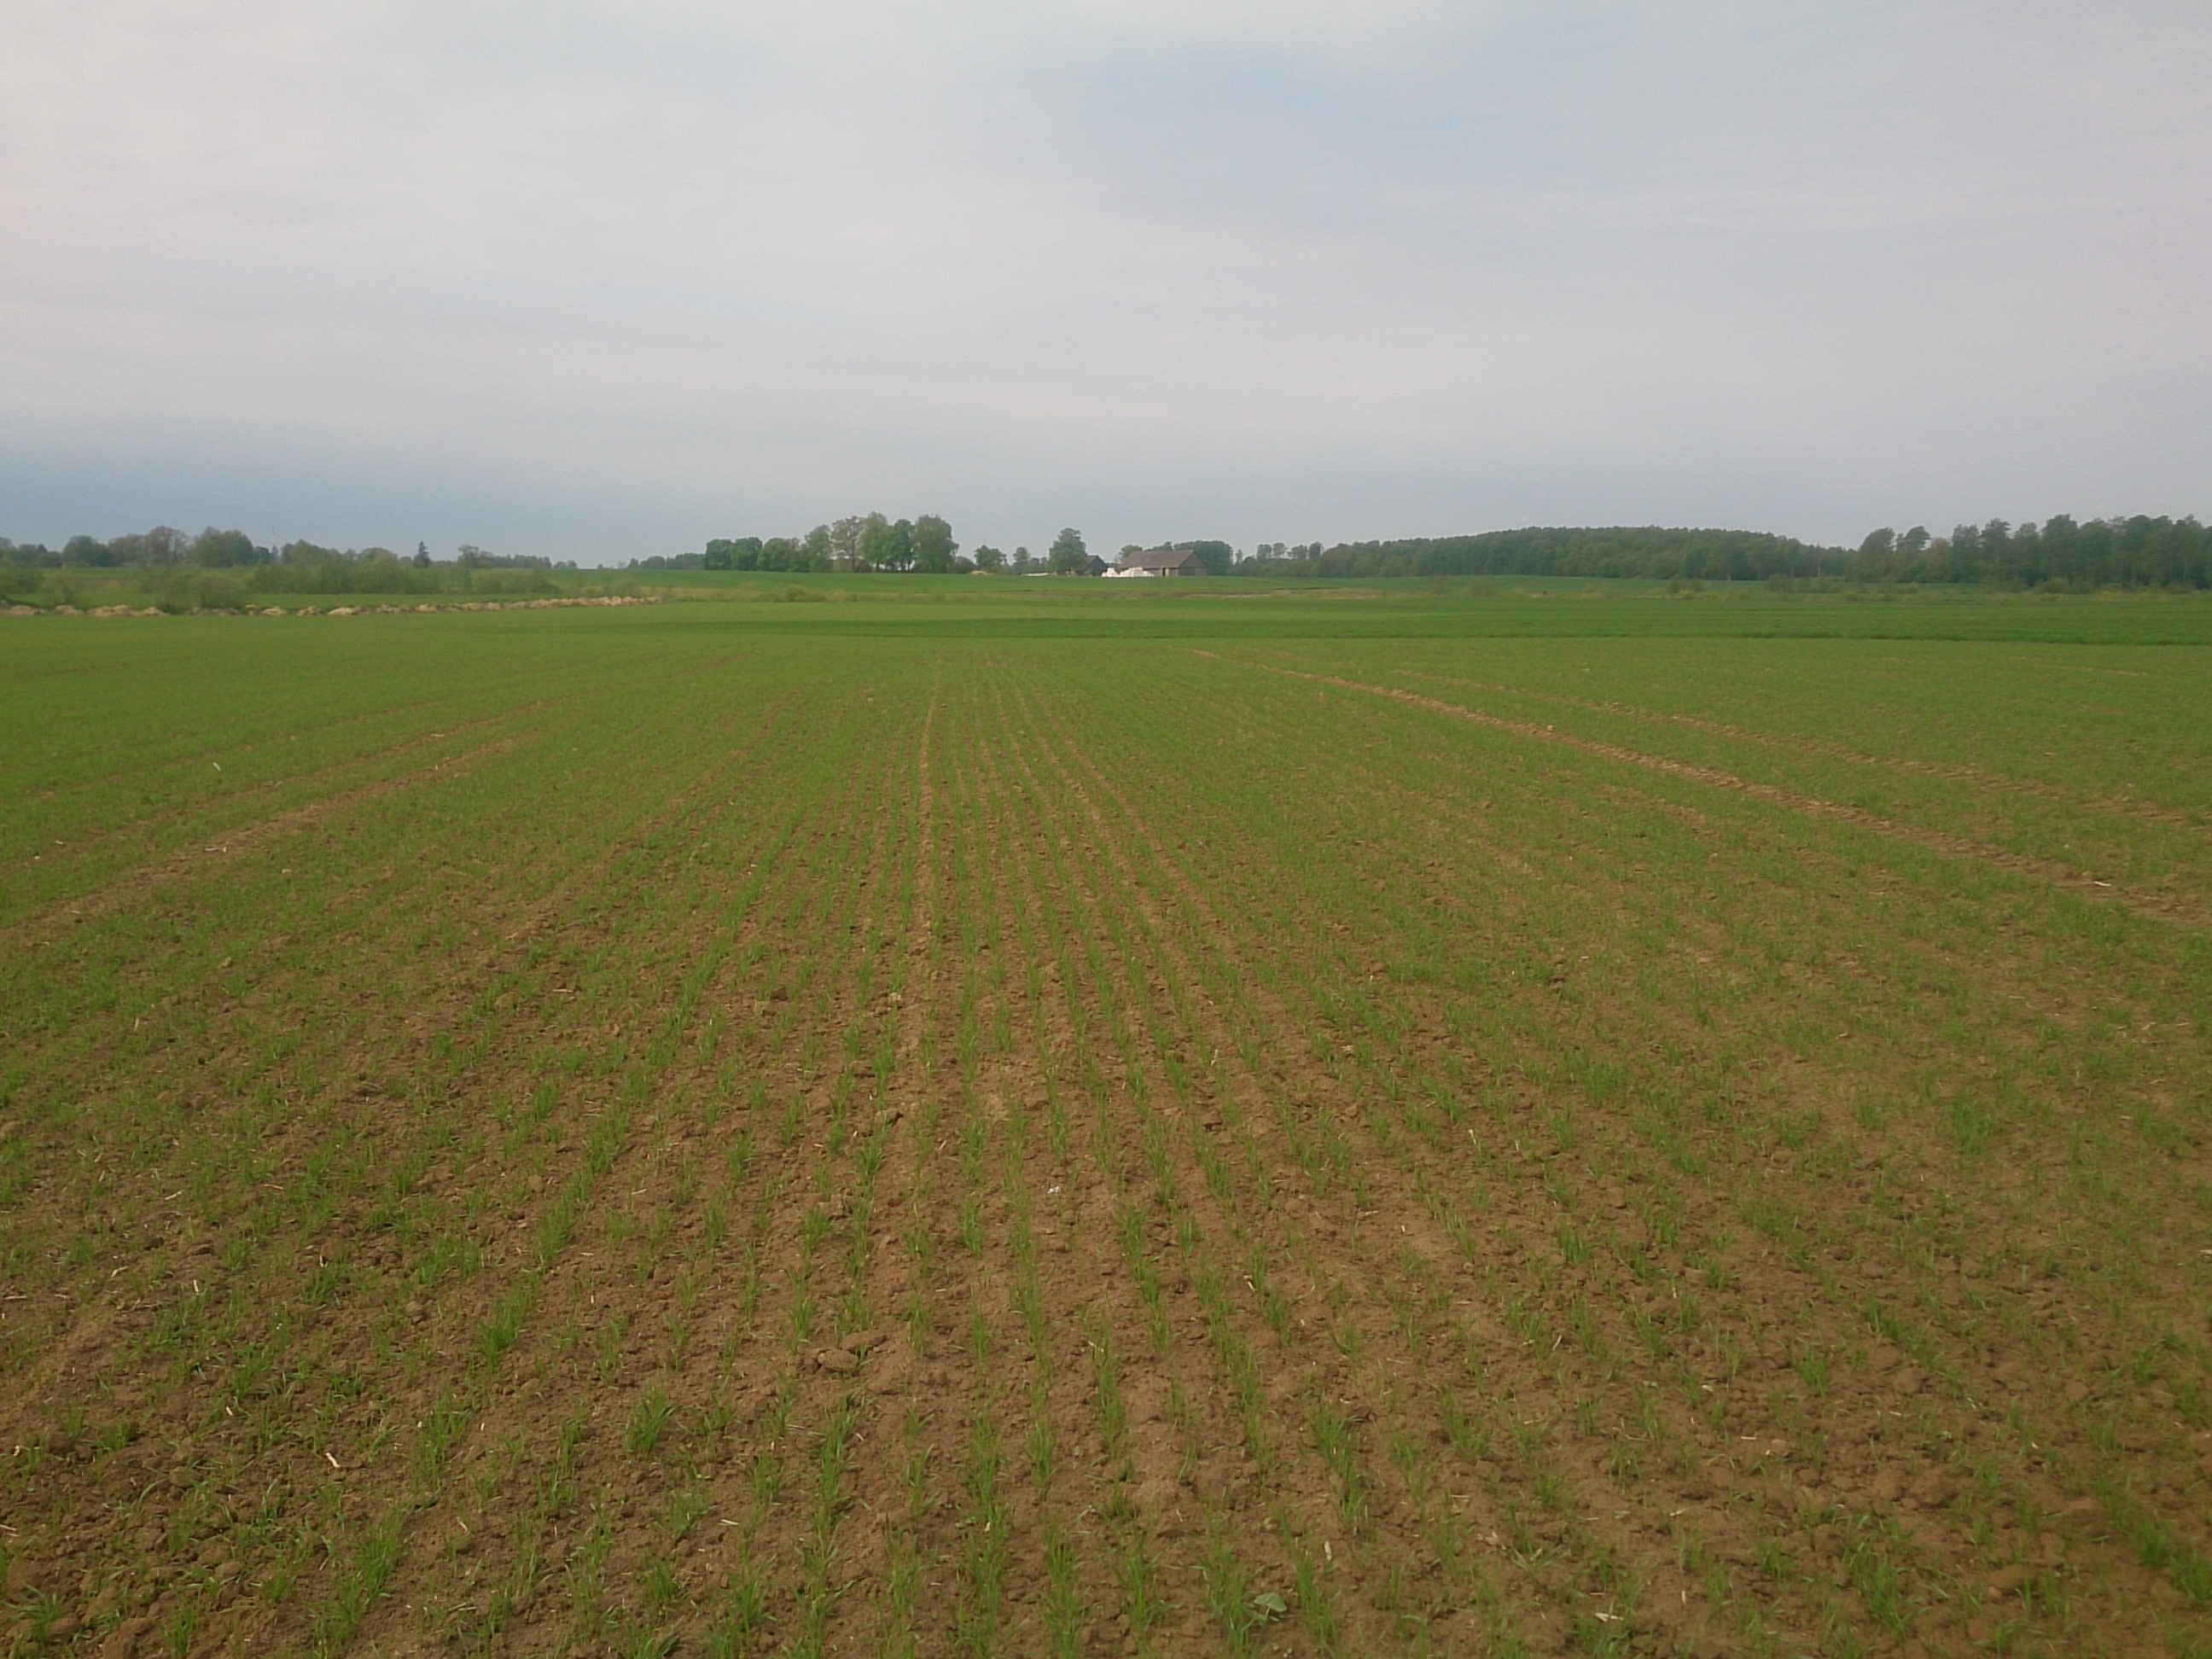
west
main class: Cropland
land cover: Common wheat
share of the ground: 50 - 75 %
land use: Agriculture (excluding fallow land and kitchen gardens)
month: May
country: LV
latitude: 56.5143
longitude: 24.1456
